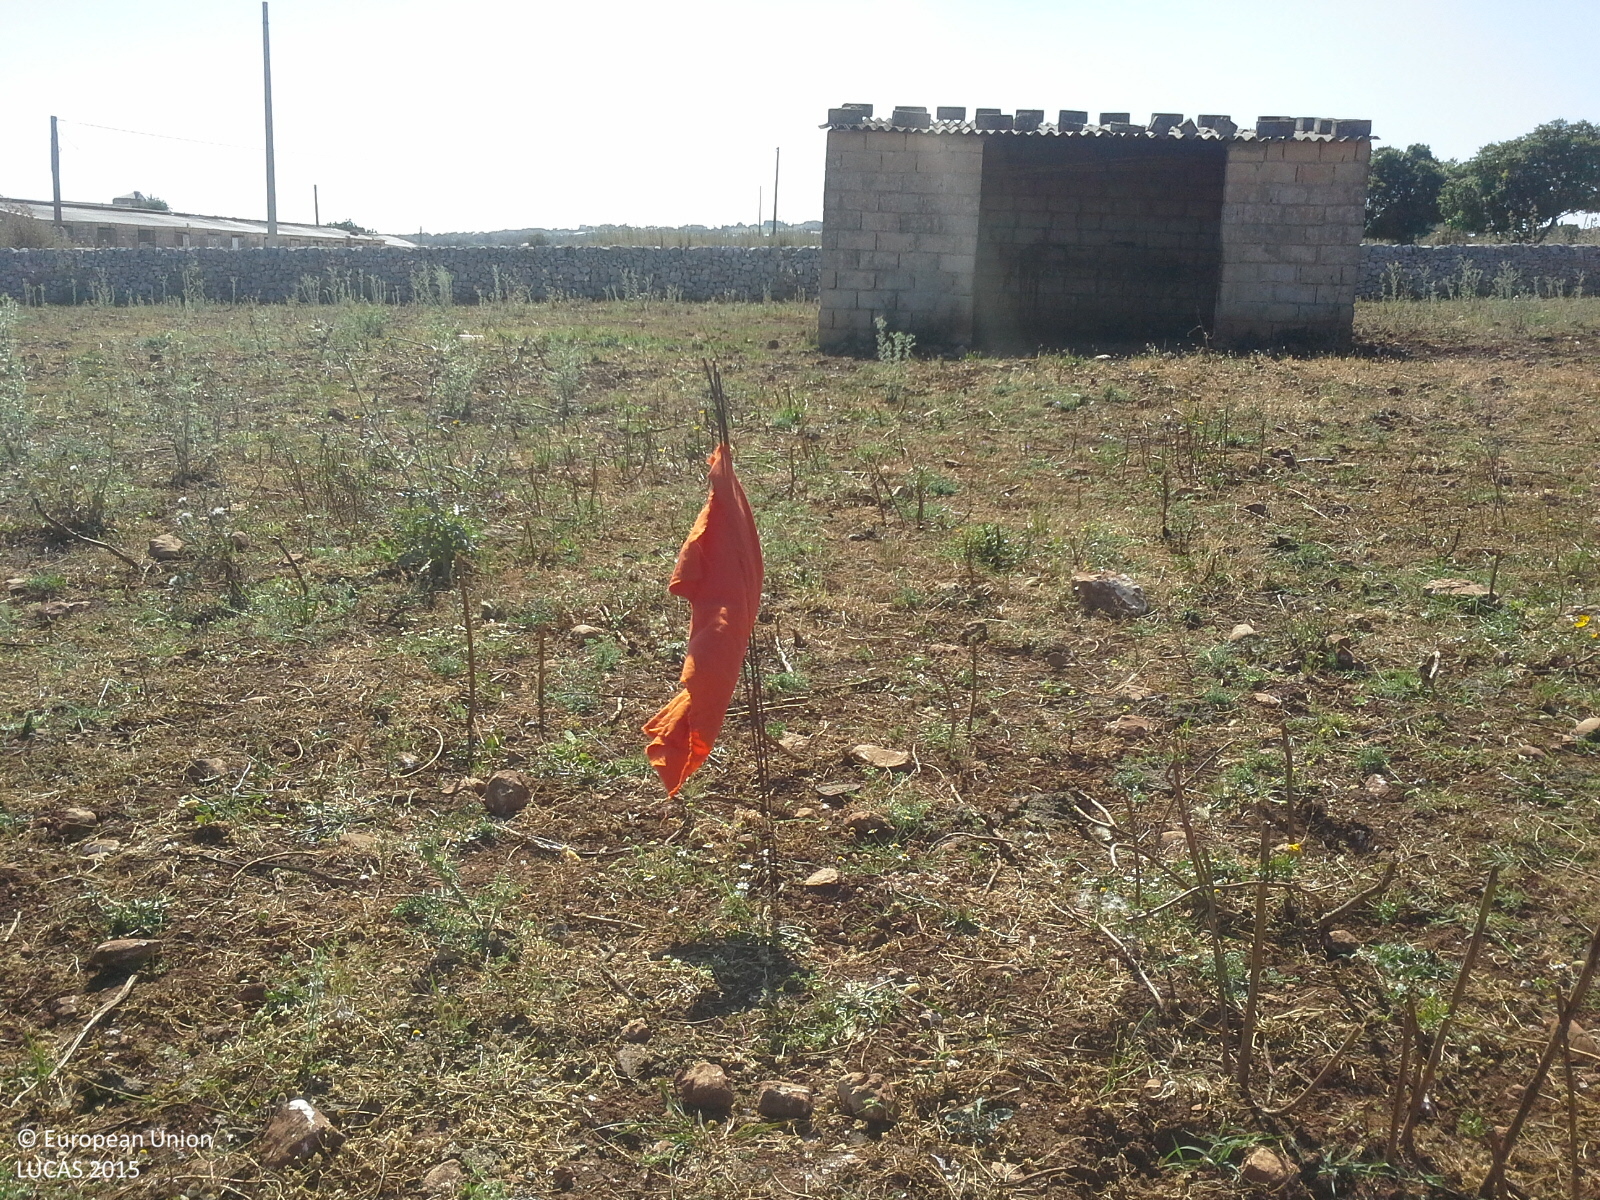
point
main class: Cropland
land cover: Mixed cereals for fodder
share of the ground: > 75 %
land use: Agriculture (excluding fallow land and kitchen gardens)
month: May
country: IT
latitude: 36.8058
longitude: 14.8368
